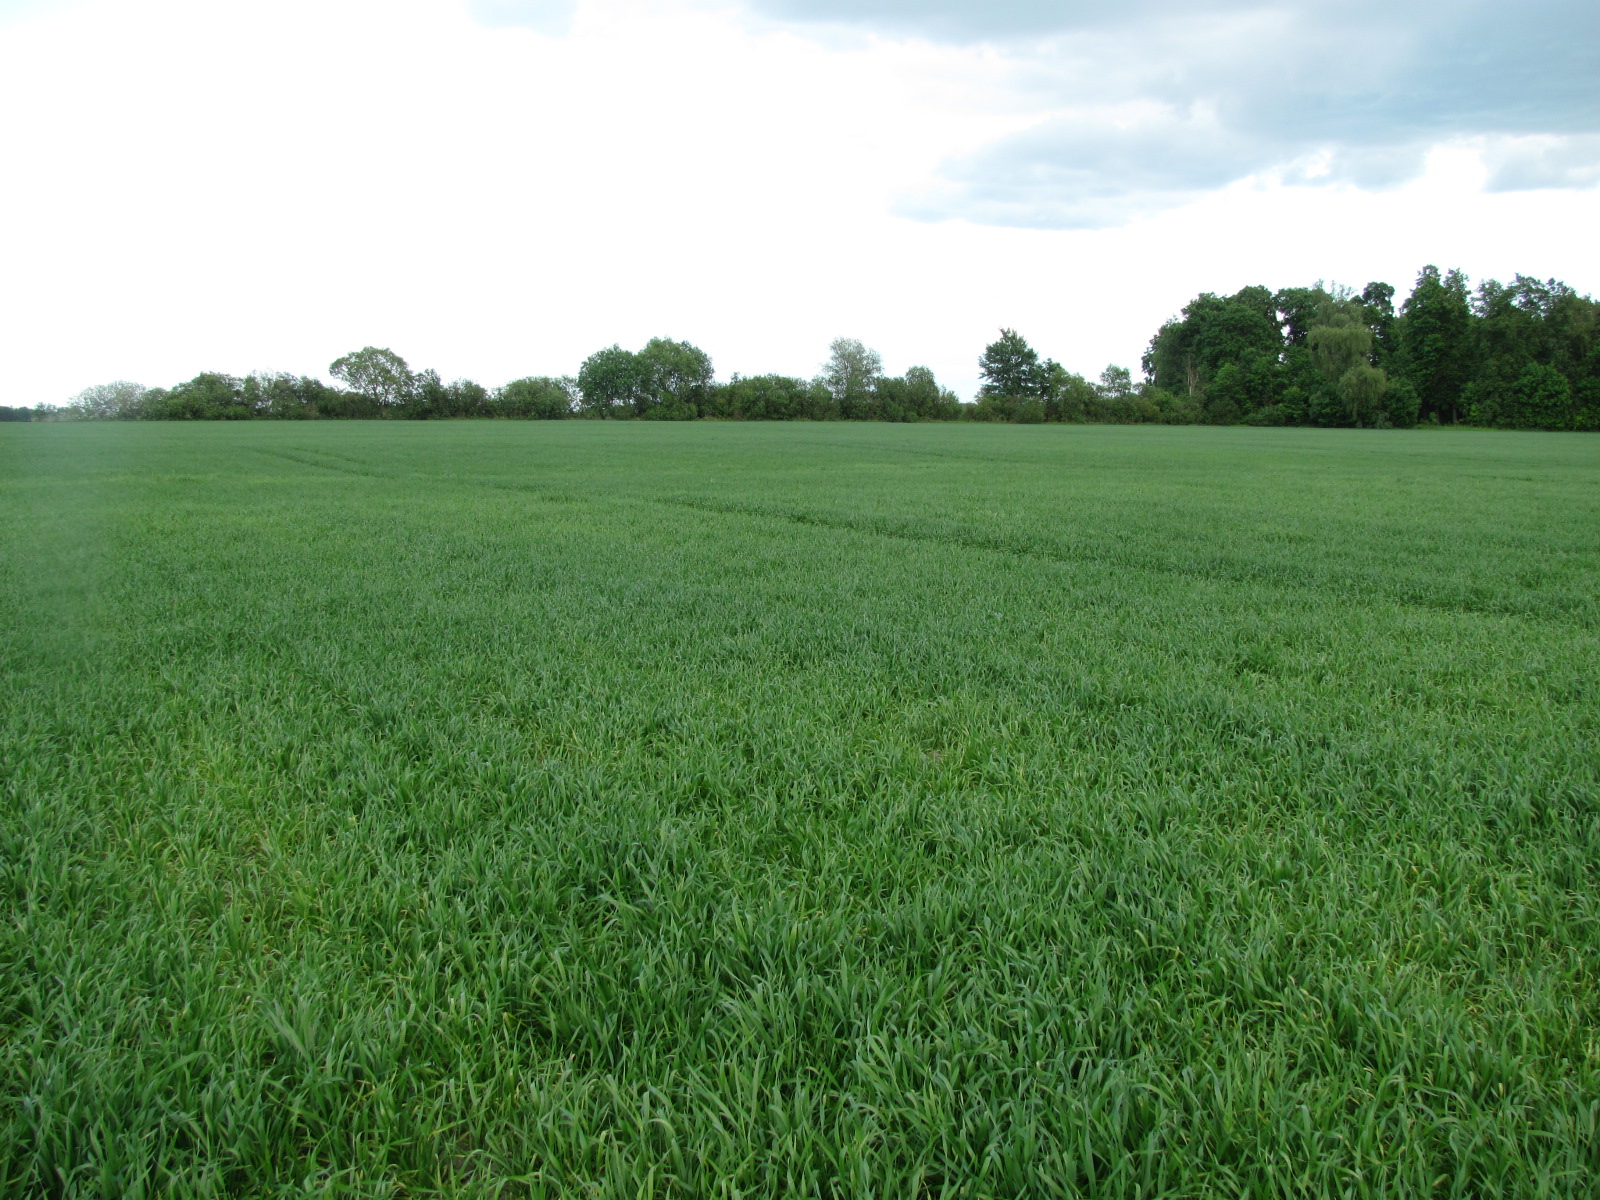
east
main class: Cropland
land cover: Common wheat
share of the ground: > 75 %
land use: Agriculture (excluding fallow land and kitchen gardens)
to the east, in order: Common wheat; Broadleaved woodland; Common wheat
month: June
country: LV
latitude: 56.3772
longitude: 24.2270
